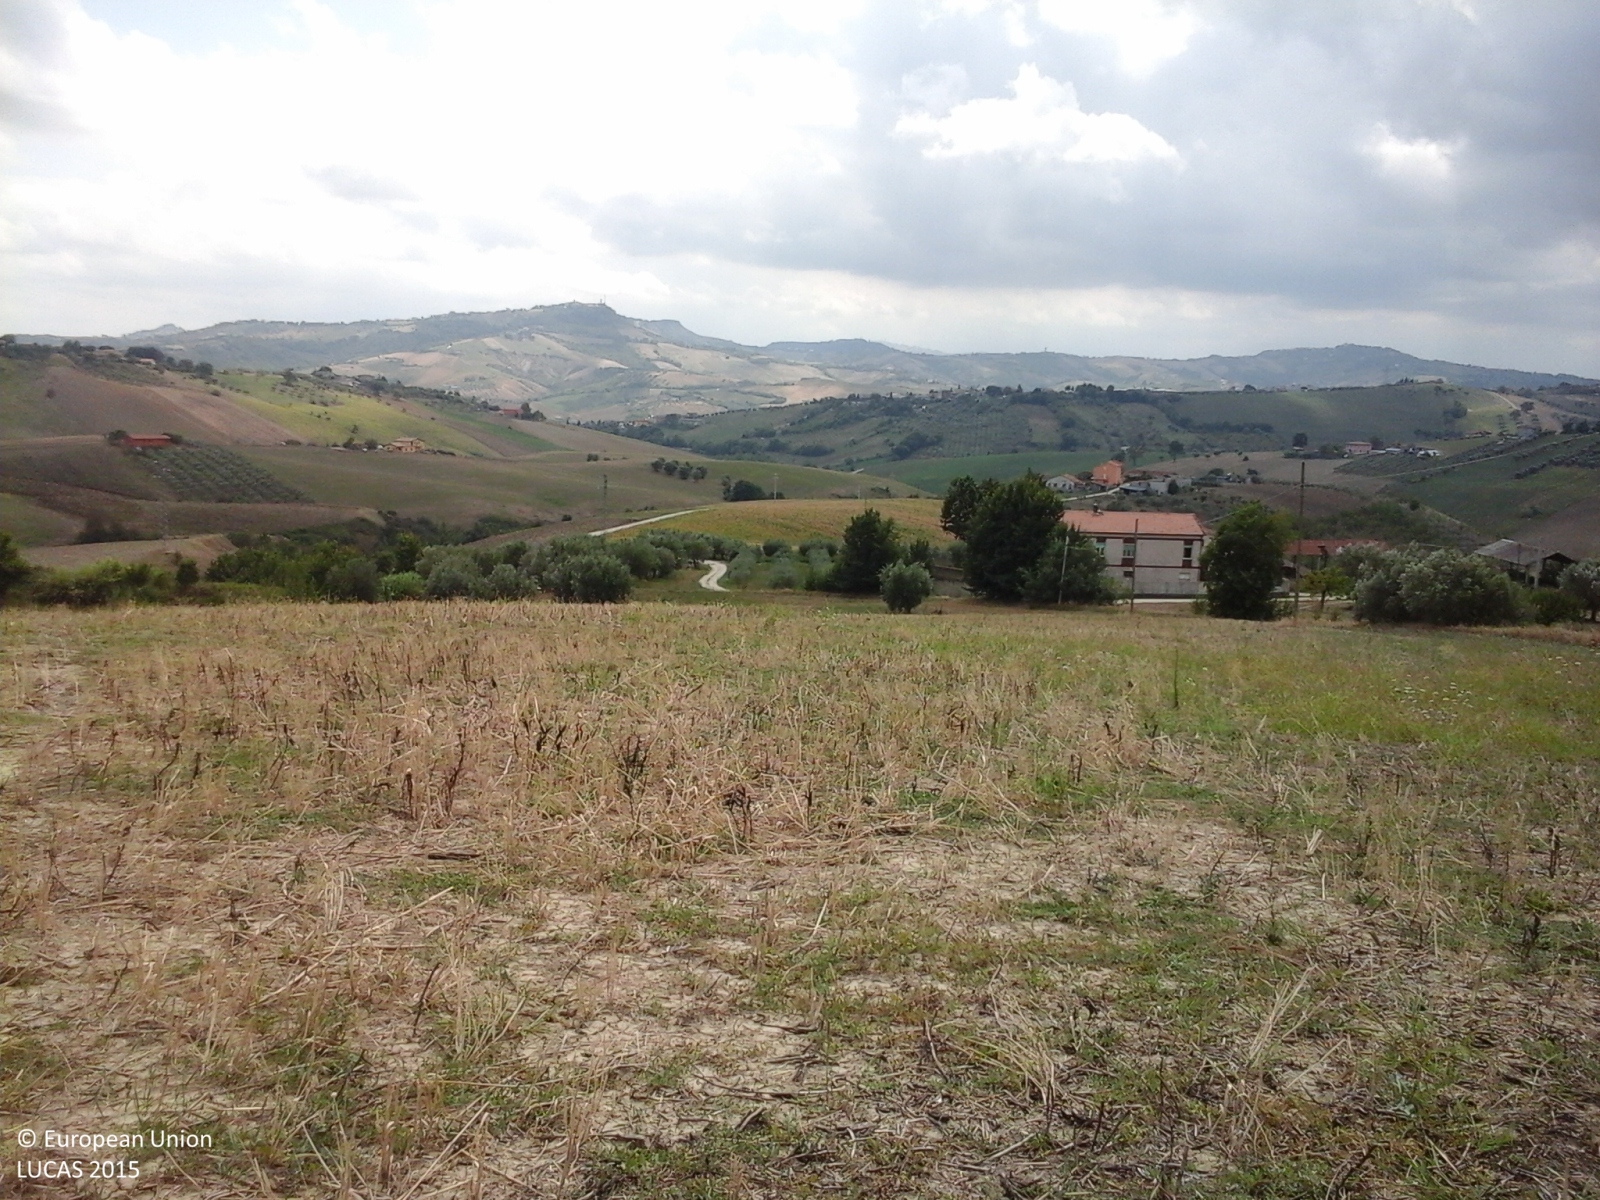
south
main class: Cropland
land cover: Dry pulses
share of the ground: < 10 %
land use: Agriculture (excluding fallow land and kitchen gardens)
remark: Harvested field
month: August
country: IT
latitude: 42.7269
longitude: 13.8117
